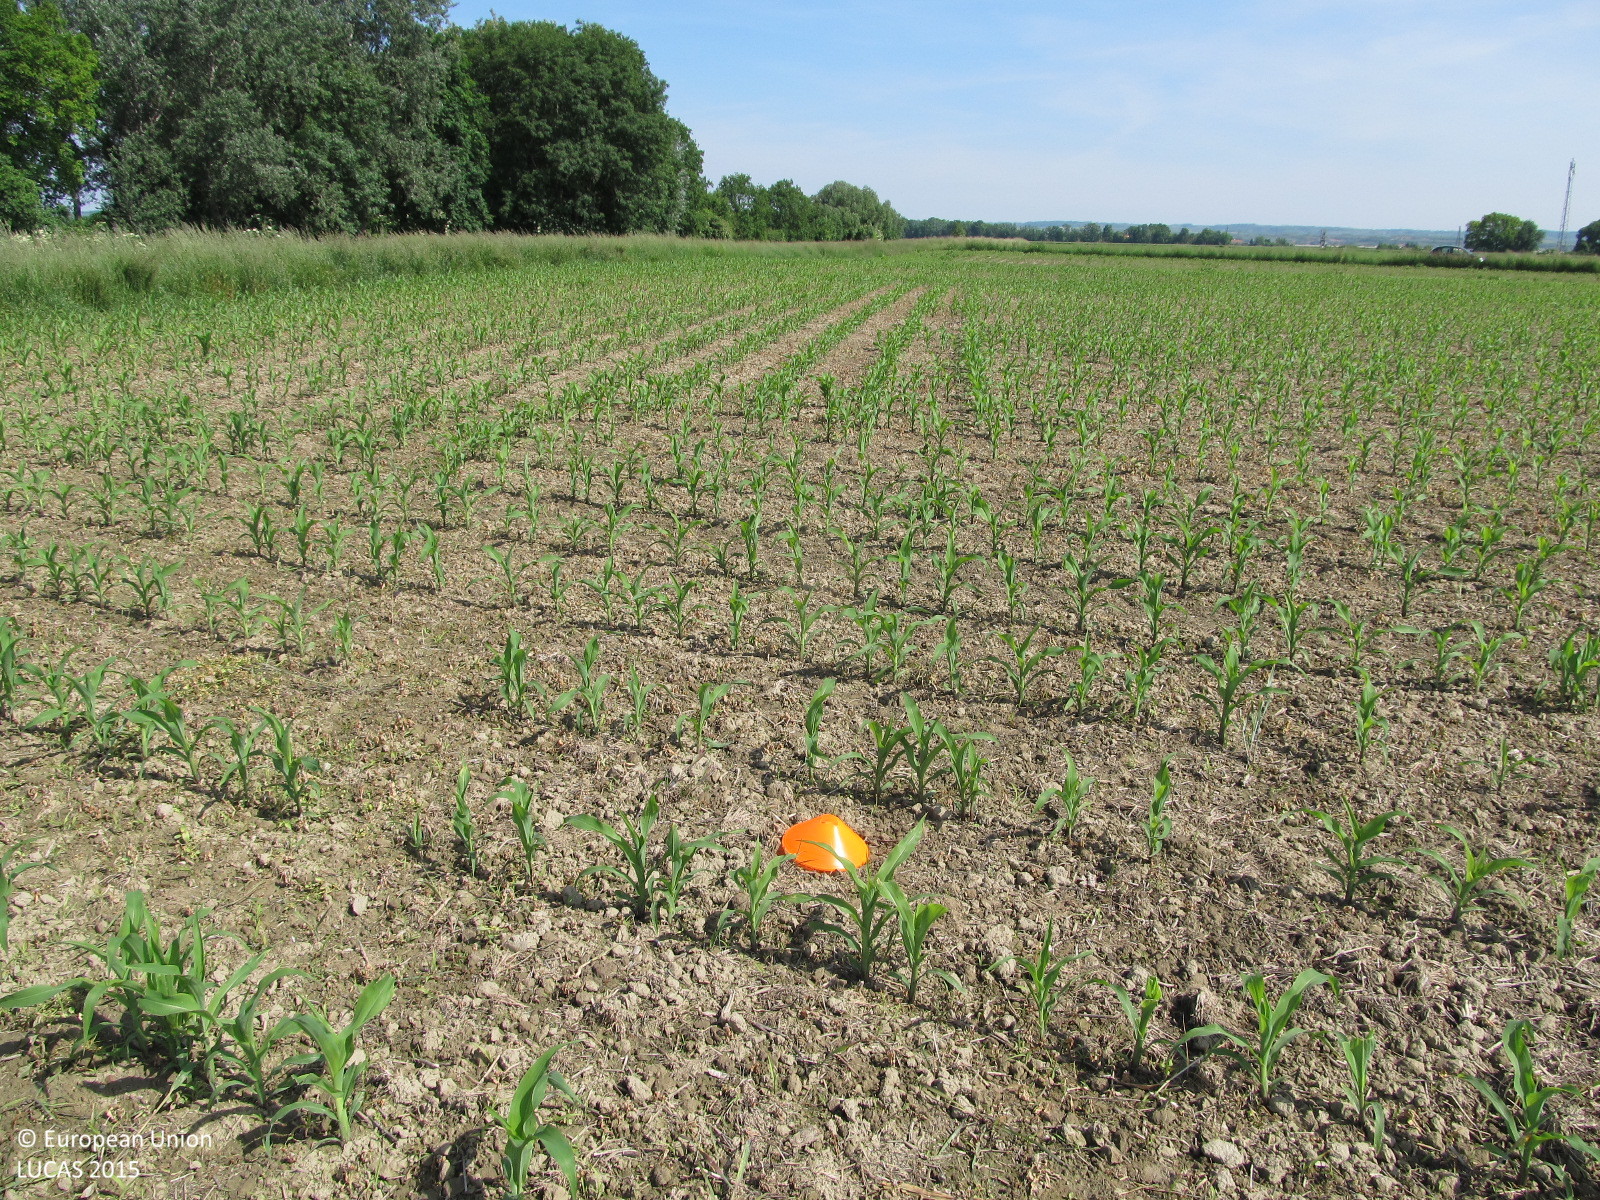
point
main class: Cropland
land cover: Maize
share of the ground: < 10 %
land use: Agriculture (excluding fallow land and kitchen gardens)
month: May
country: AT
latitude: 48.3929
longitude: 15.8514
